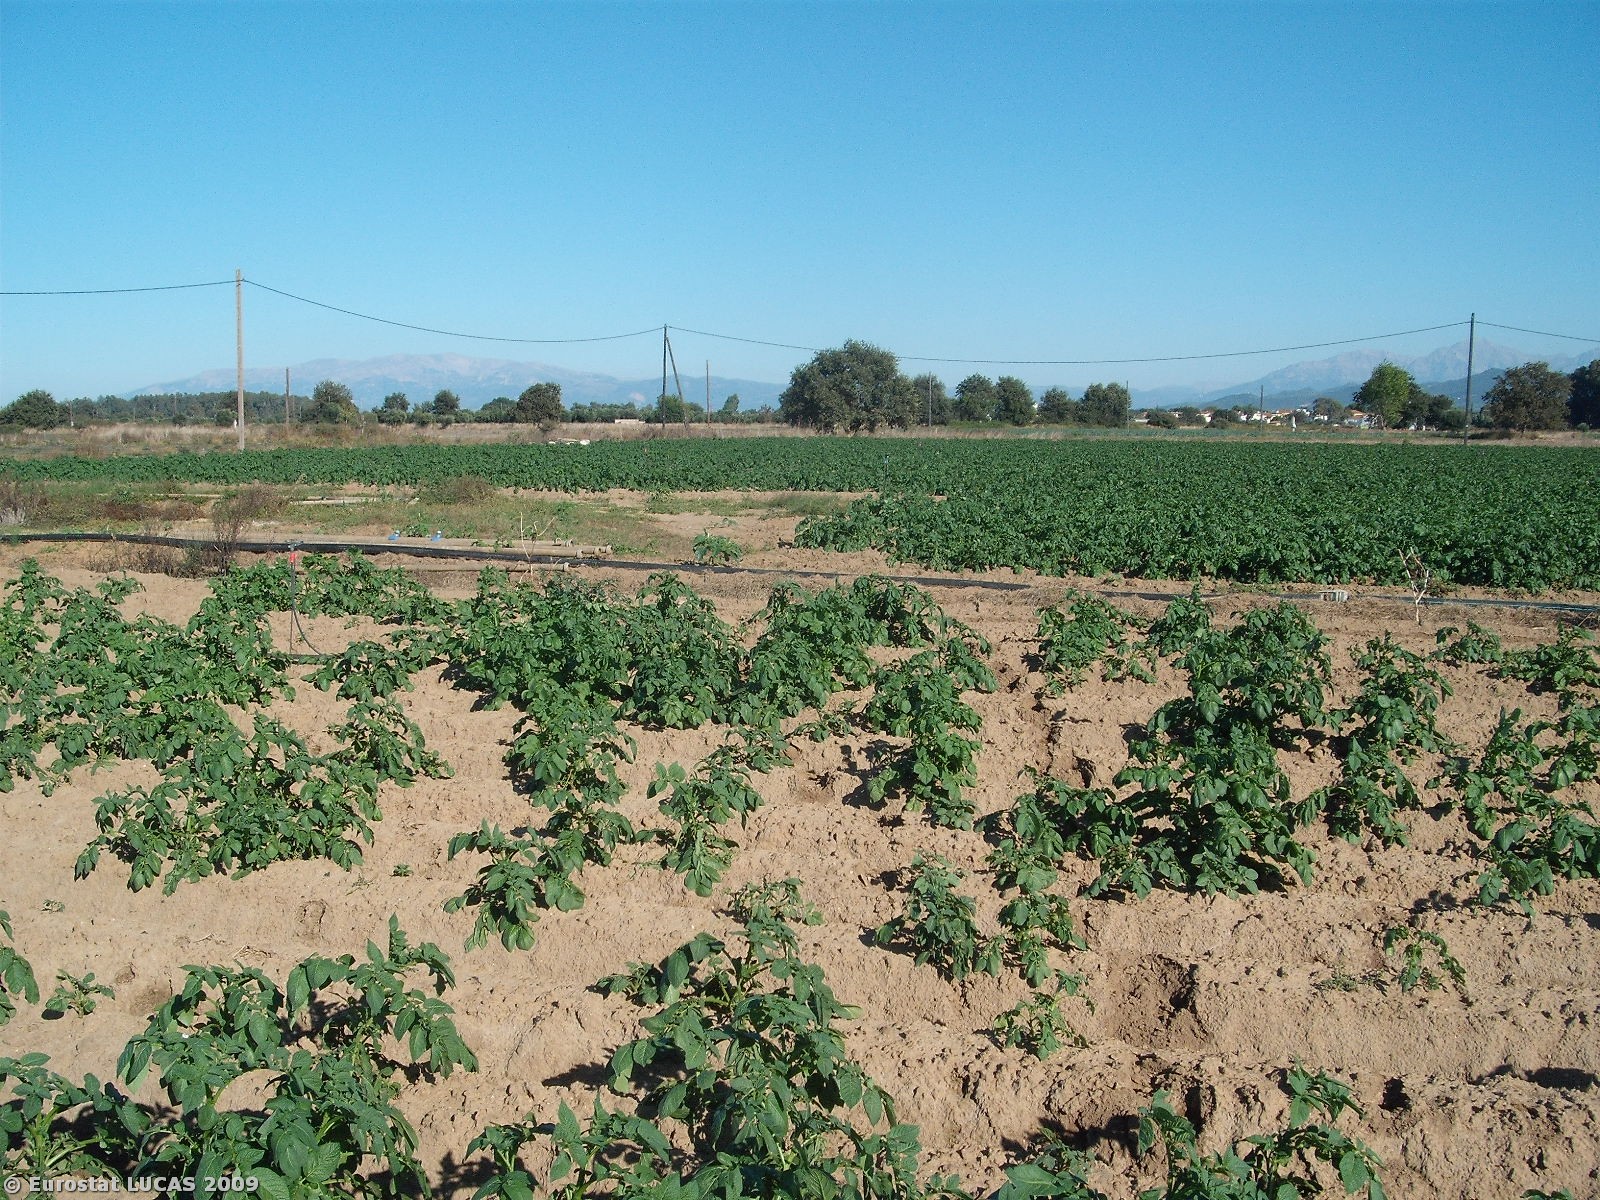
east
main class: Cropland
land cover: Potatoes
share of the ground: 50 - 75 %
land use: Agriculture (excluding fallow land and kitchen gardens)
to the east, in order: Potatoes; Ditches and canals; Potatoes; Electric lines; Fences; Oats; Potatoes; Grass margins; Tracks; Fences; Spontaneously vegetated surfaces; Fences; Spontaneously vegetated surfaces
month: October
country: GR
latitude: 38.1021
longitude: 21.4018
